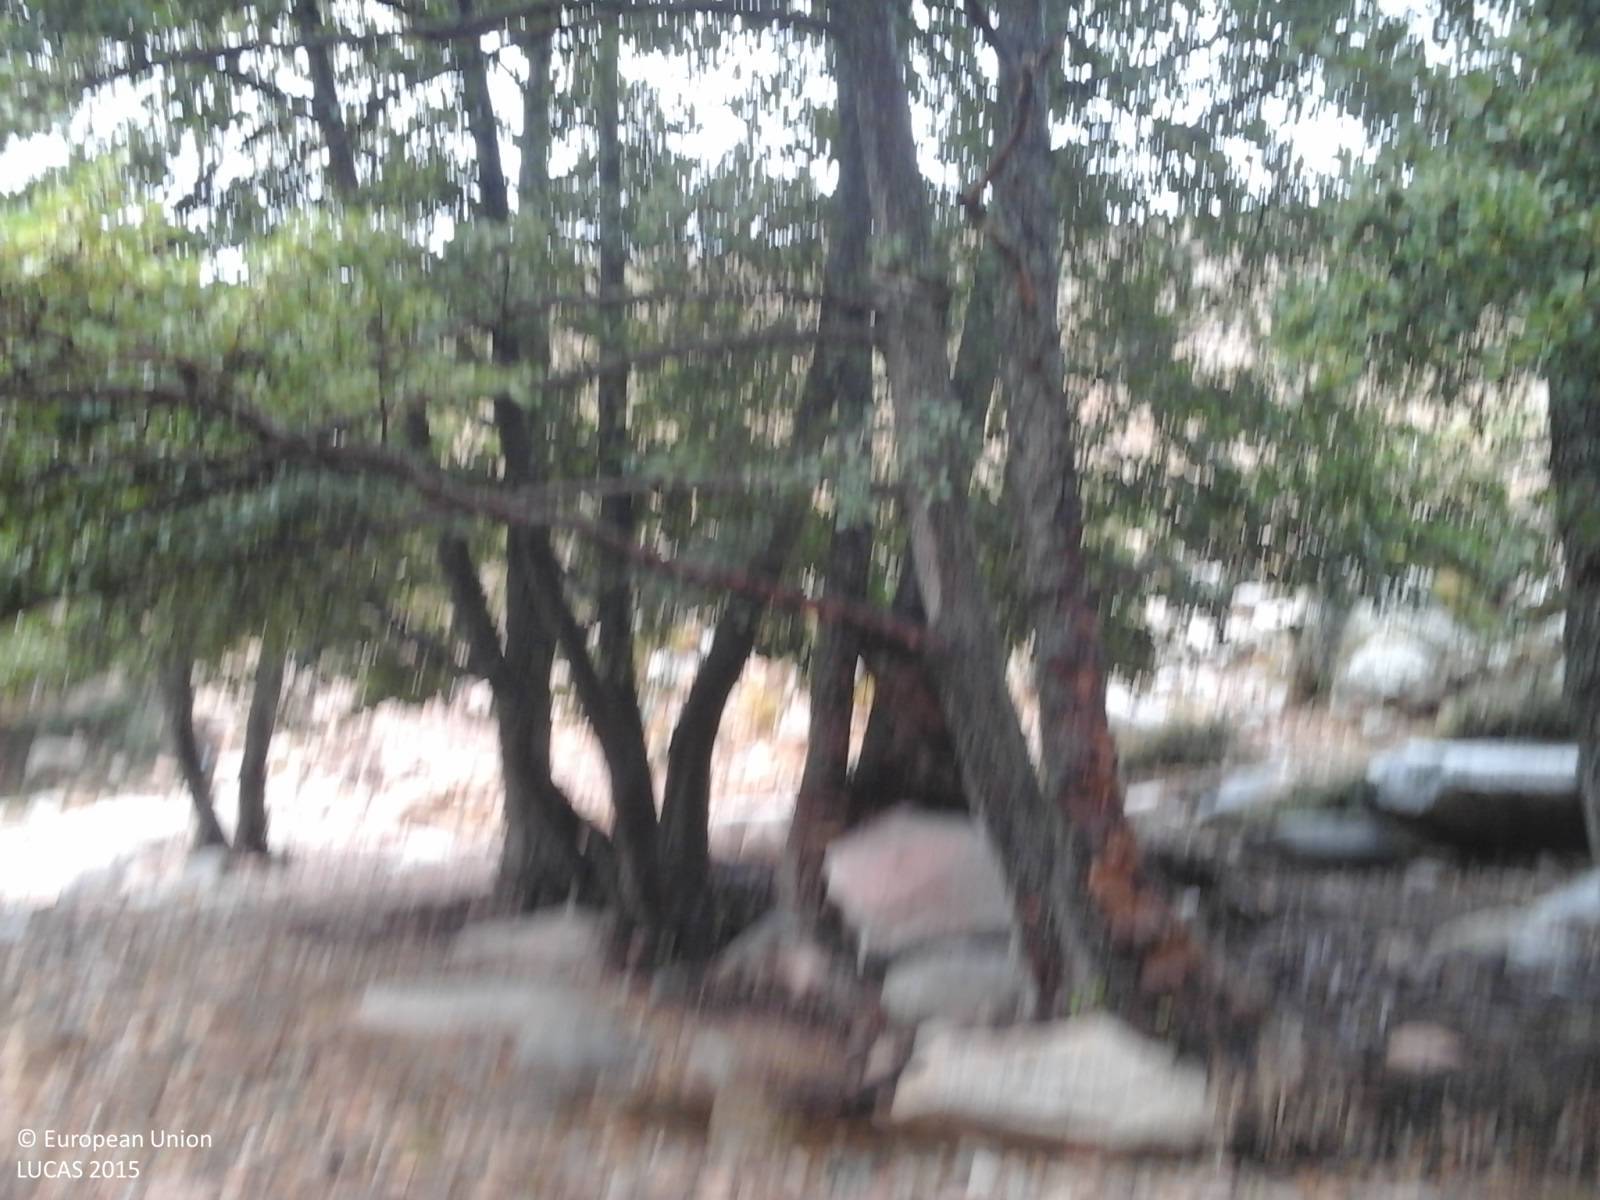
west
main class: Shrubland
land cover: Shrubland without tree cover
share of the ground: > 75 %
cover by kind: consolidated bare surface 40 %, shrubs 25 %, unconsolidated bare surface 20 %, herbaceous plants 15 %
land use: Semi-natural and natural areas not in use
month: September
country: IT
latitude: 39.9392
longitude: 9.3366
